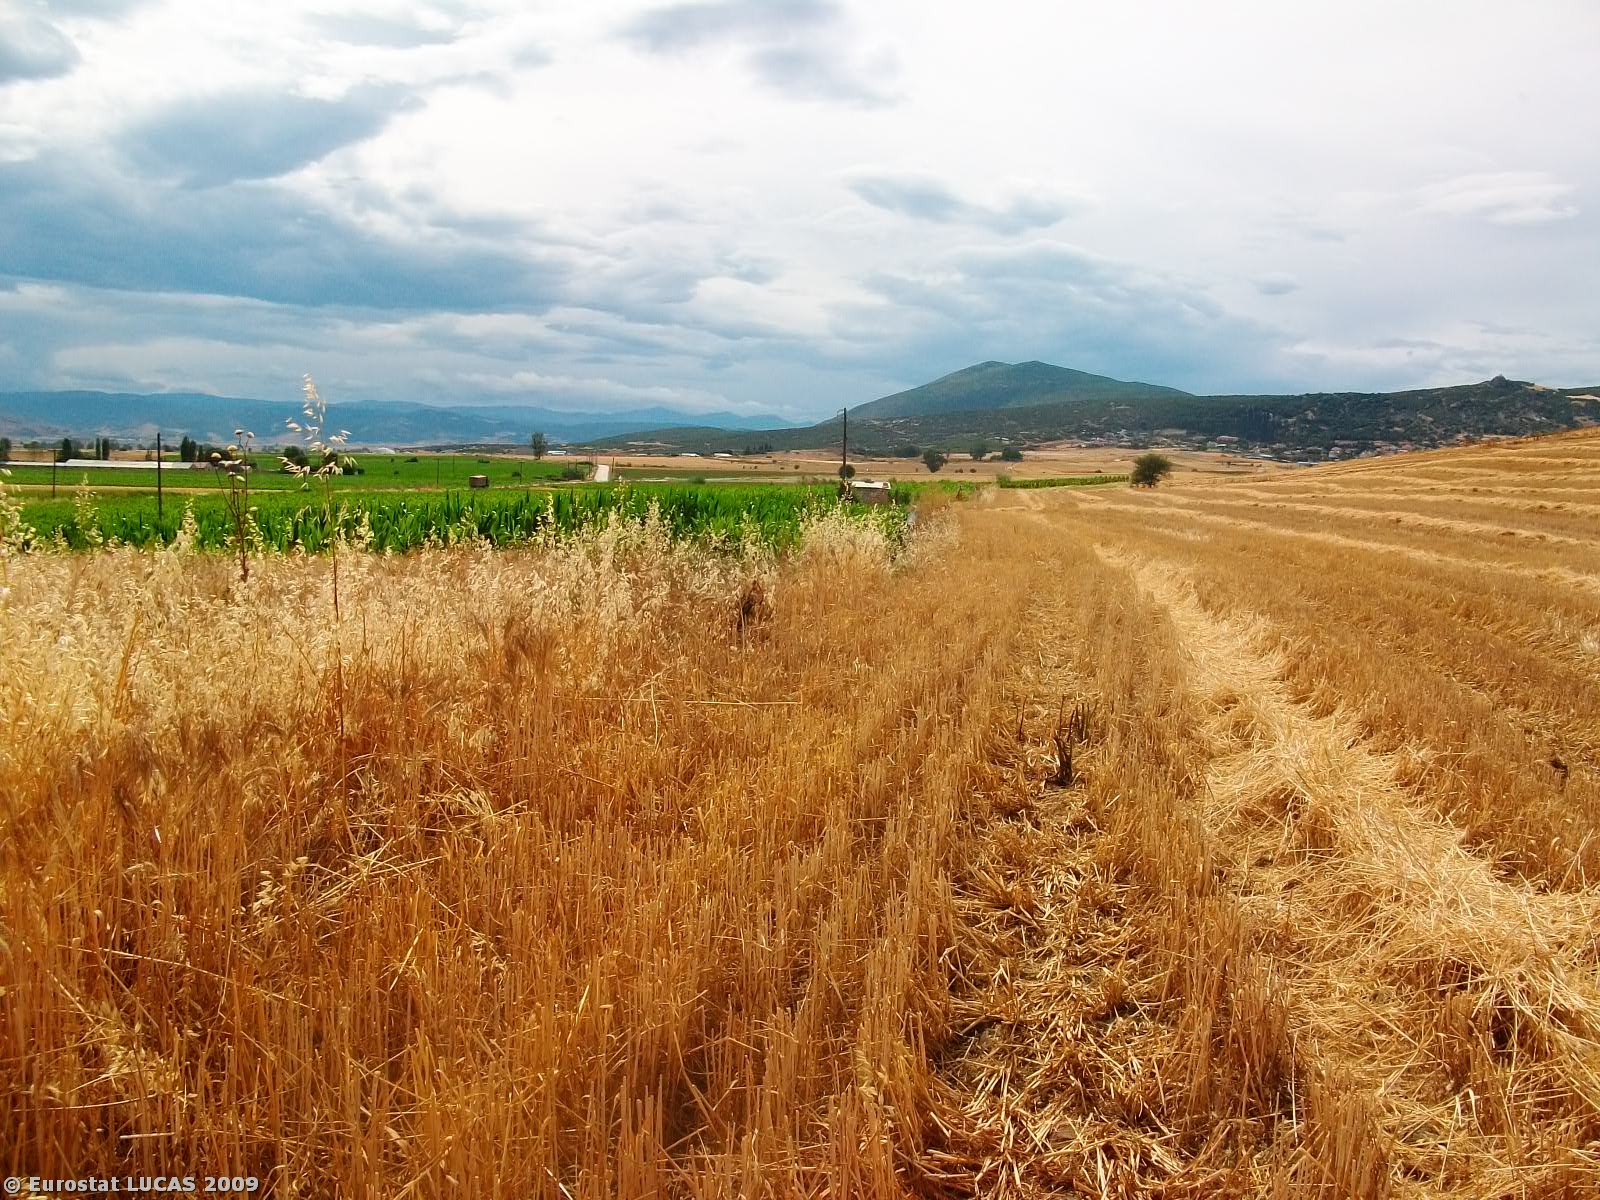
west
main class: Grassland
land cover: Spontaneously vegetated surfaces
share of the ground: > 75 %
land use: Unused
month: June
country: GR
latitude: 39.0886
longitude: 22.2945
